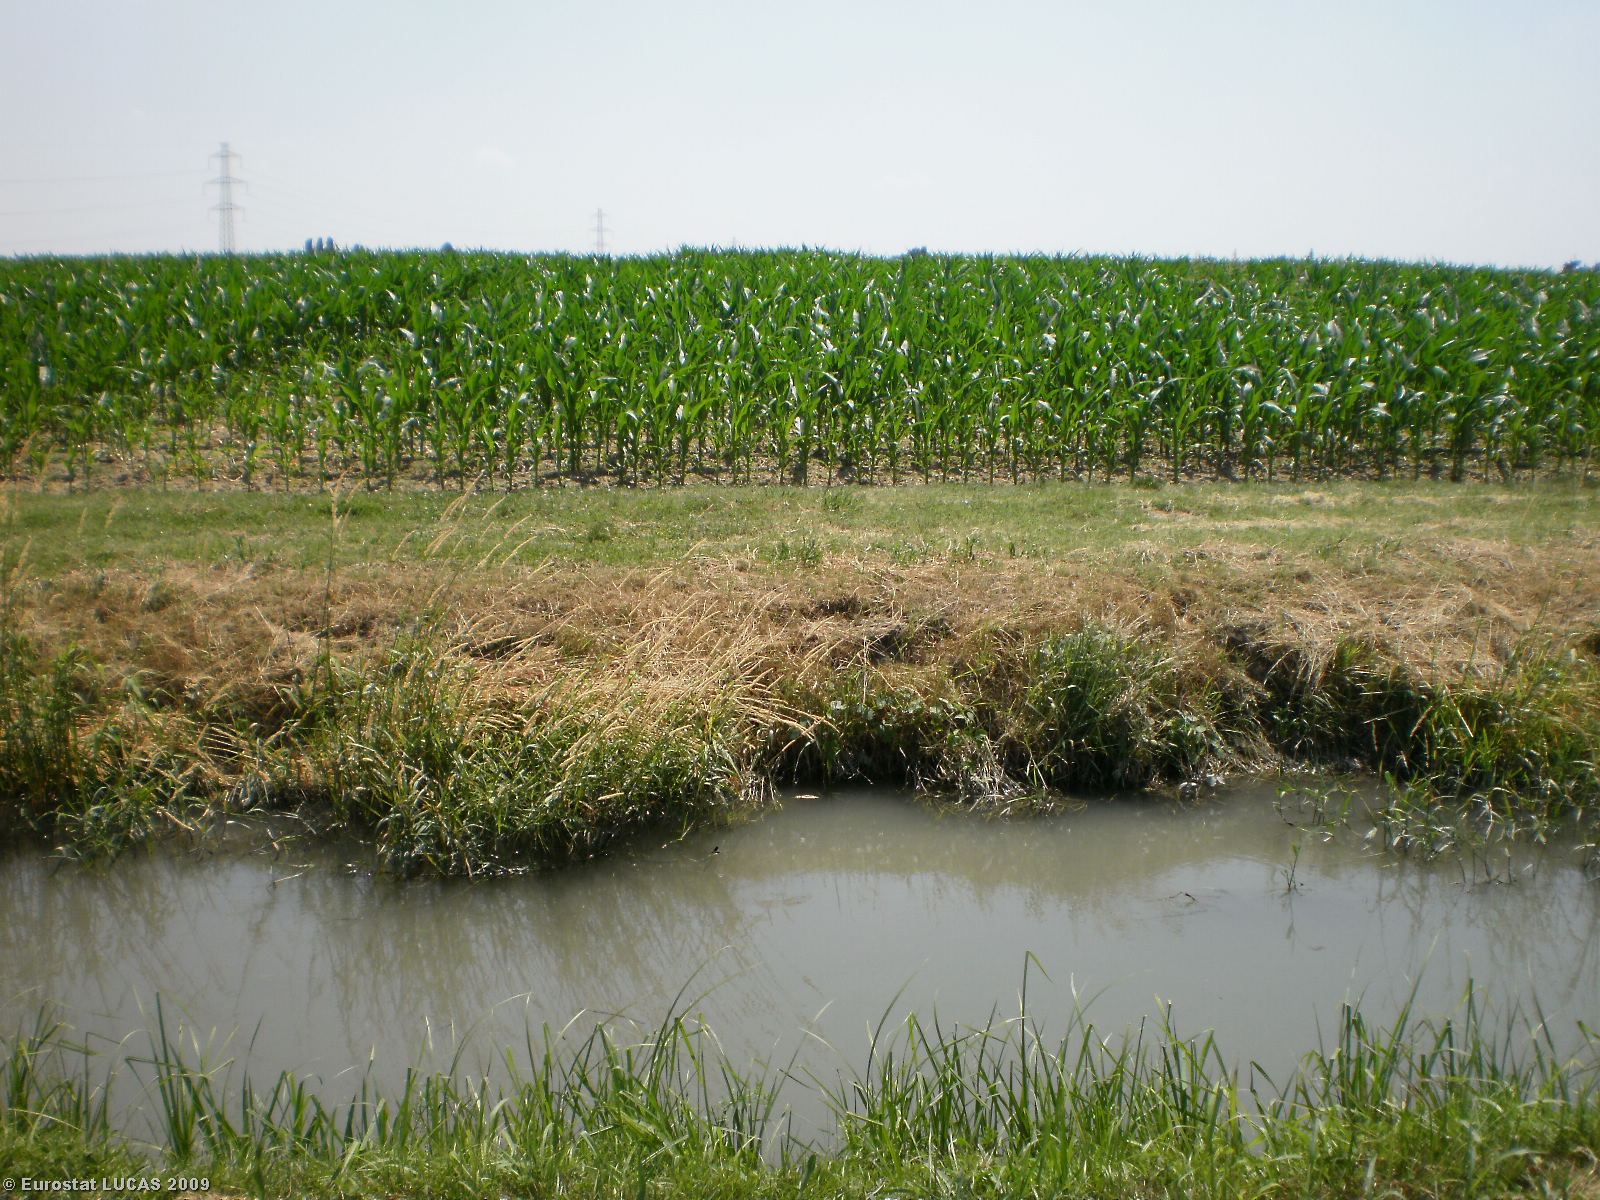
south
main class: Cropland
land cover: Common wheat
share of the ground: > 75 %
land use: Agriculture (excluding fallow land and kitchen gardens)
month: June
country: IT
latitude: 45.0168
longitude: 10.4433
